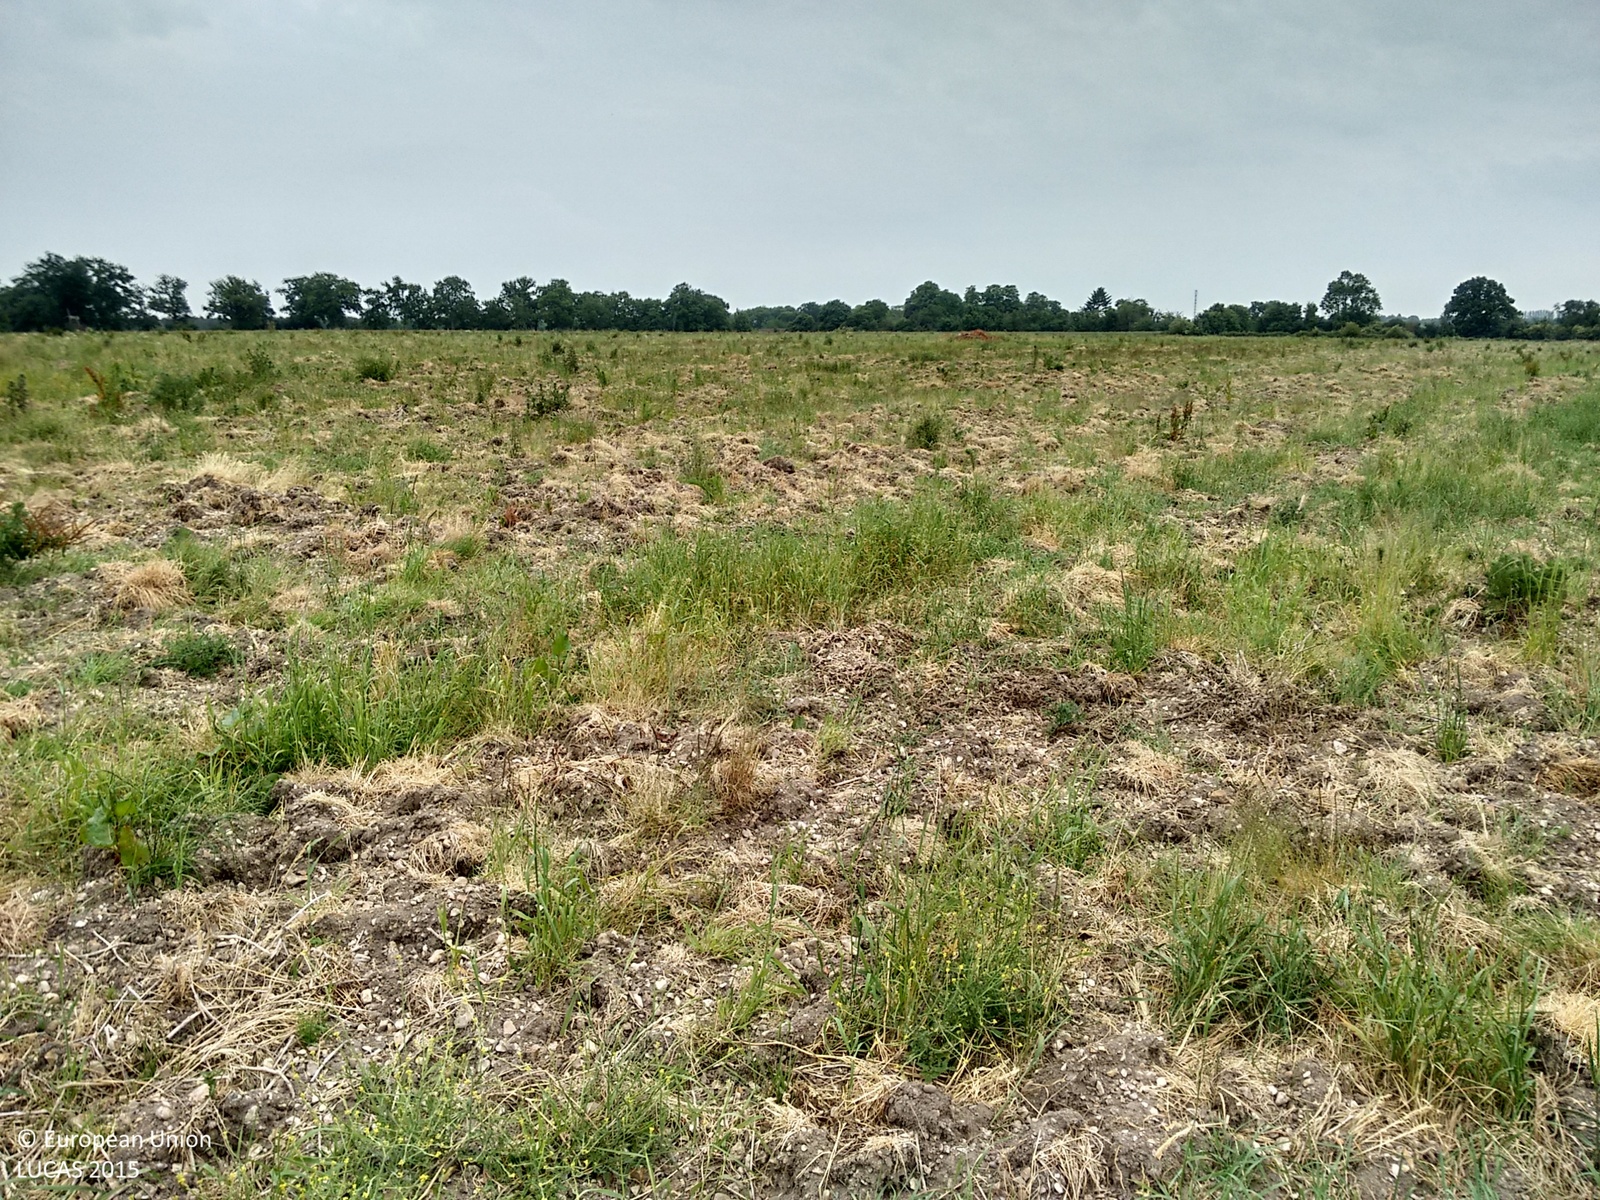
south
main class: Grassland
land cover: Grassland without tree/shrub cover
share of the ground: > 75 %
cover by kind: herbaceous plants 75 %, unconsolidated bare surface 25 %
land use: Agriculture (excluding fallow land and kitchen gardens)
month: June
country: GB
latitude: 51.4013
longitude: -1.0997
